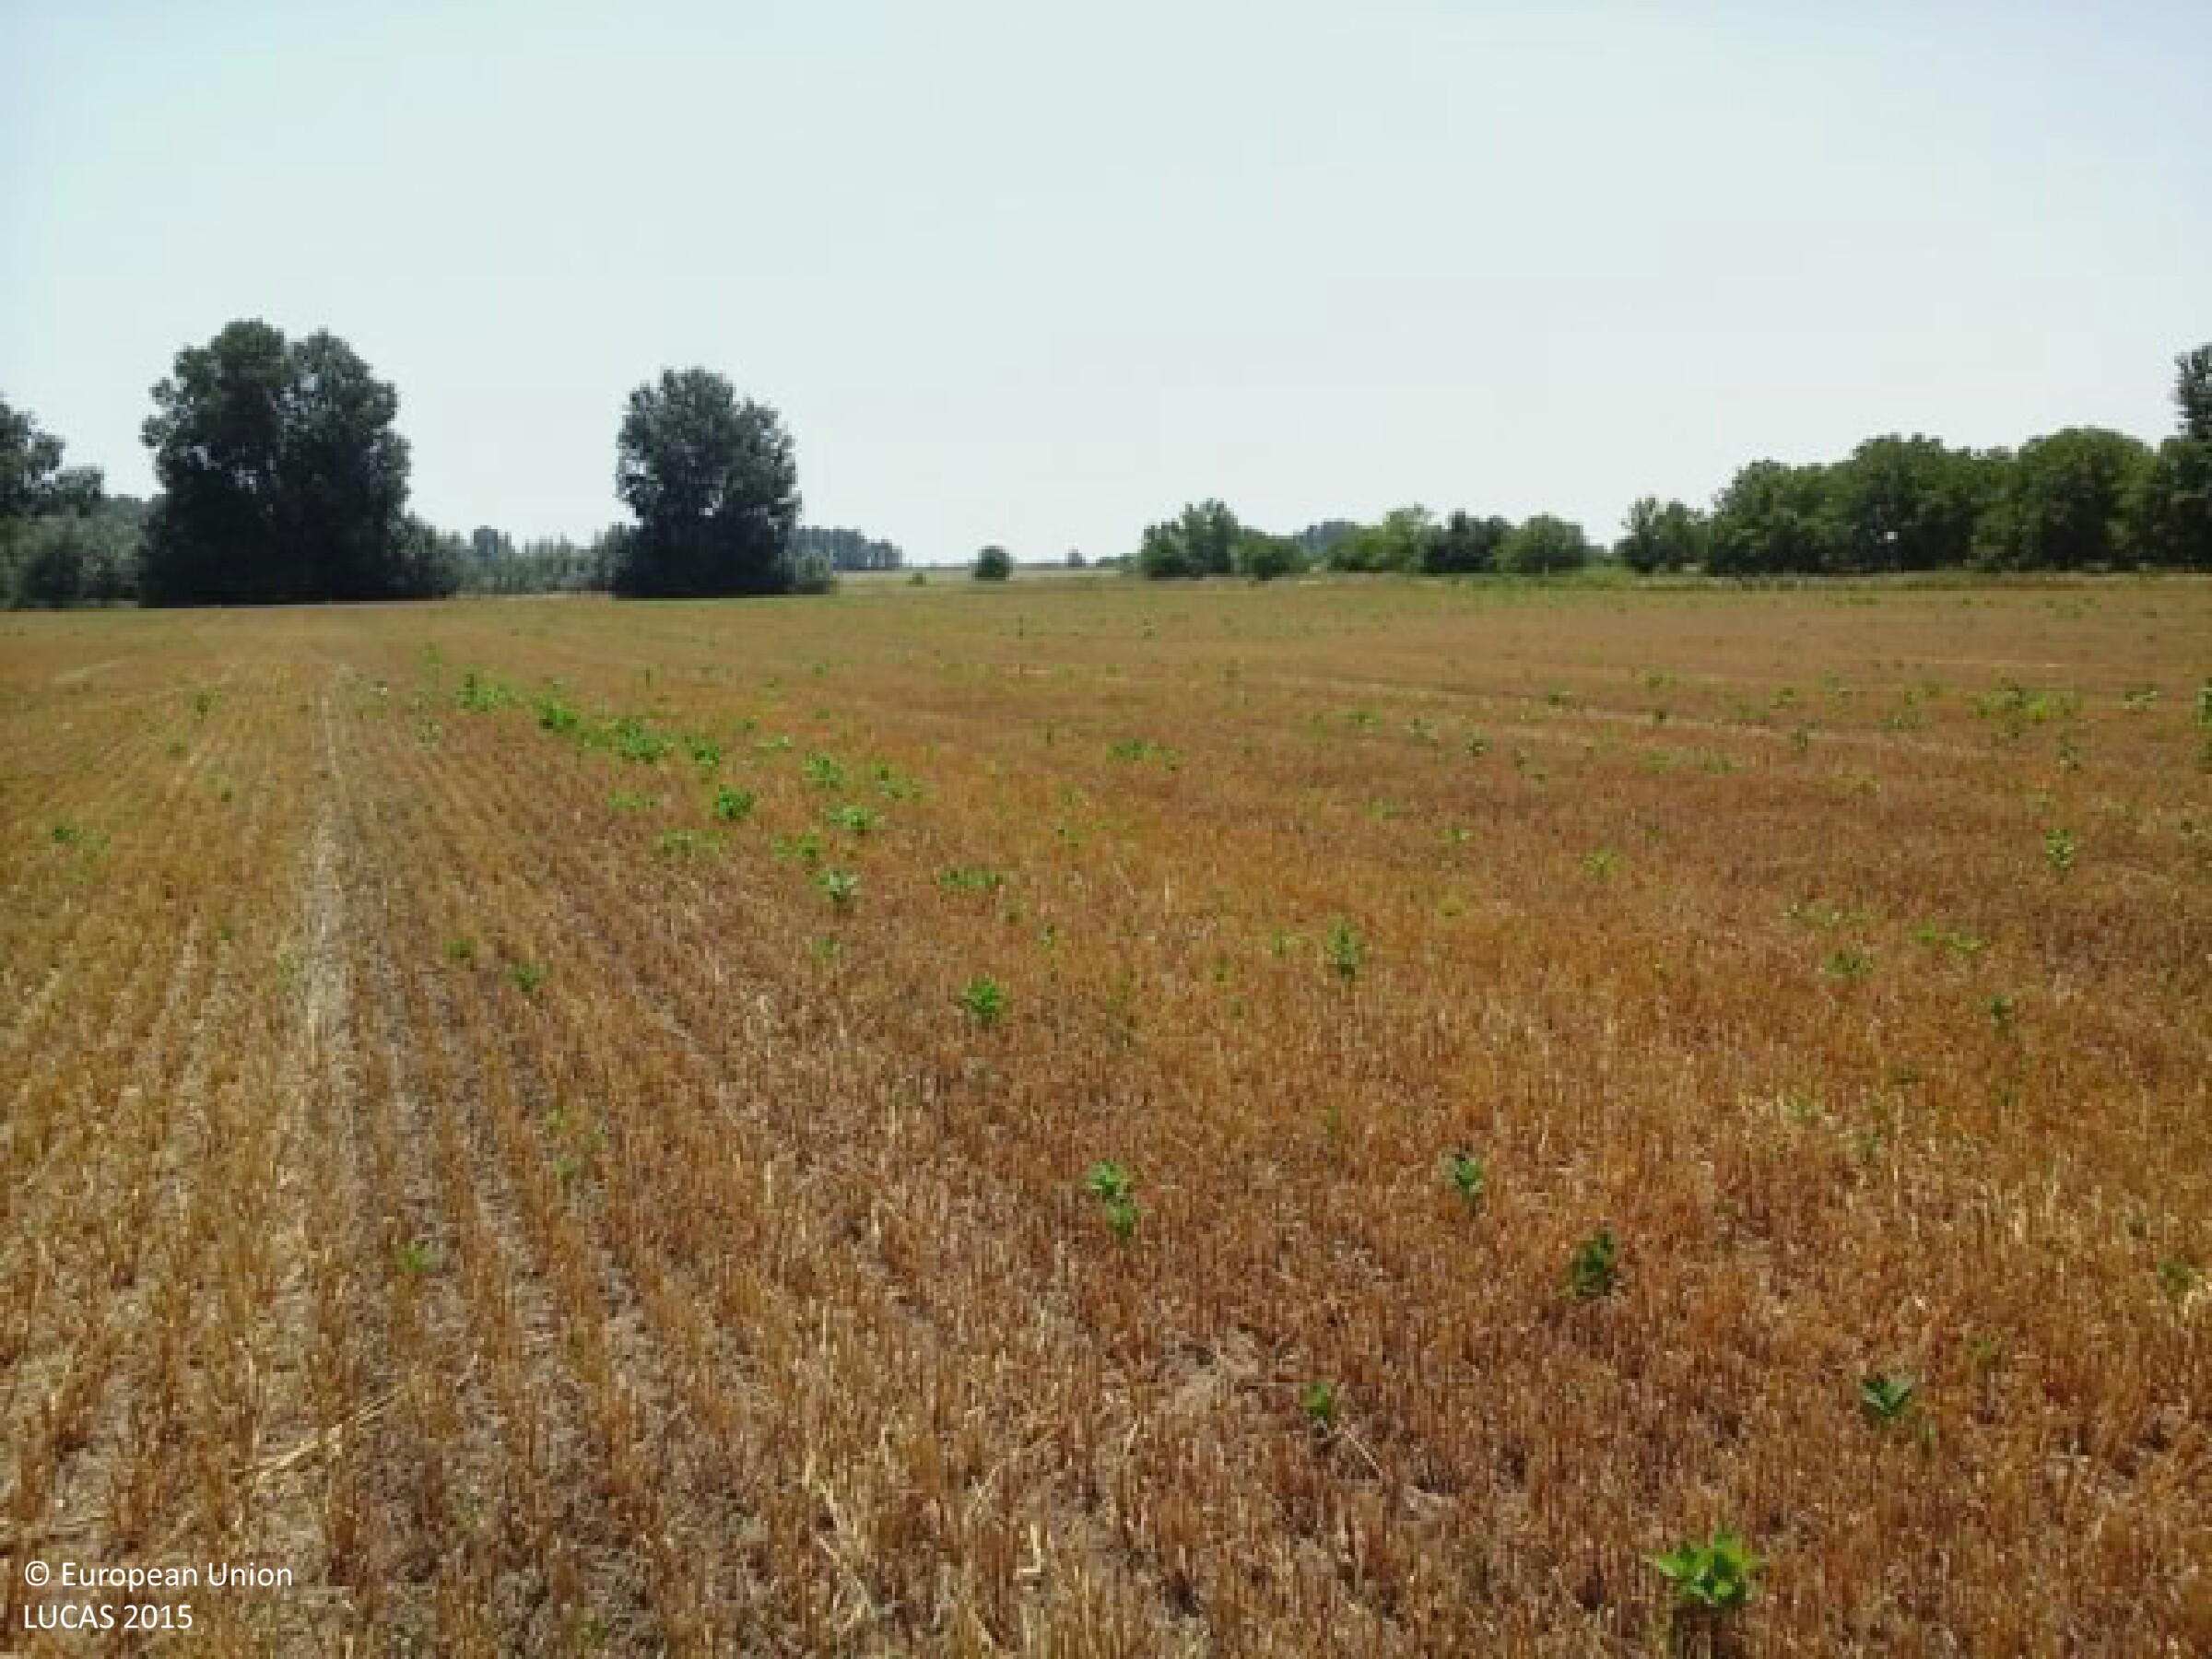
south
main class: Cropland
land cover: Barley
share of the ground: 25 - 50 %
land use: Agriculture (excluding fallow land and kitchen gardens)
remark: Harvested field
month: July
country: HU
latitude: 46.0778
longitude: 19.4415
